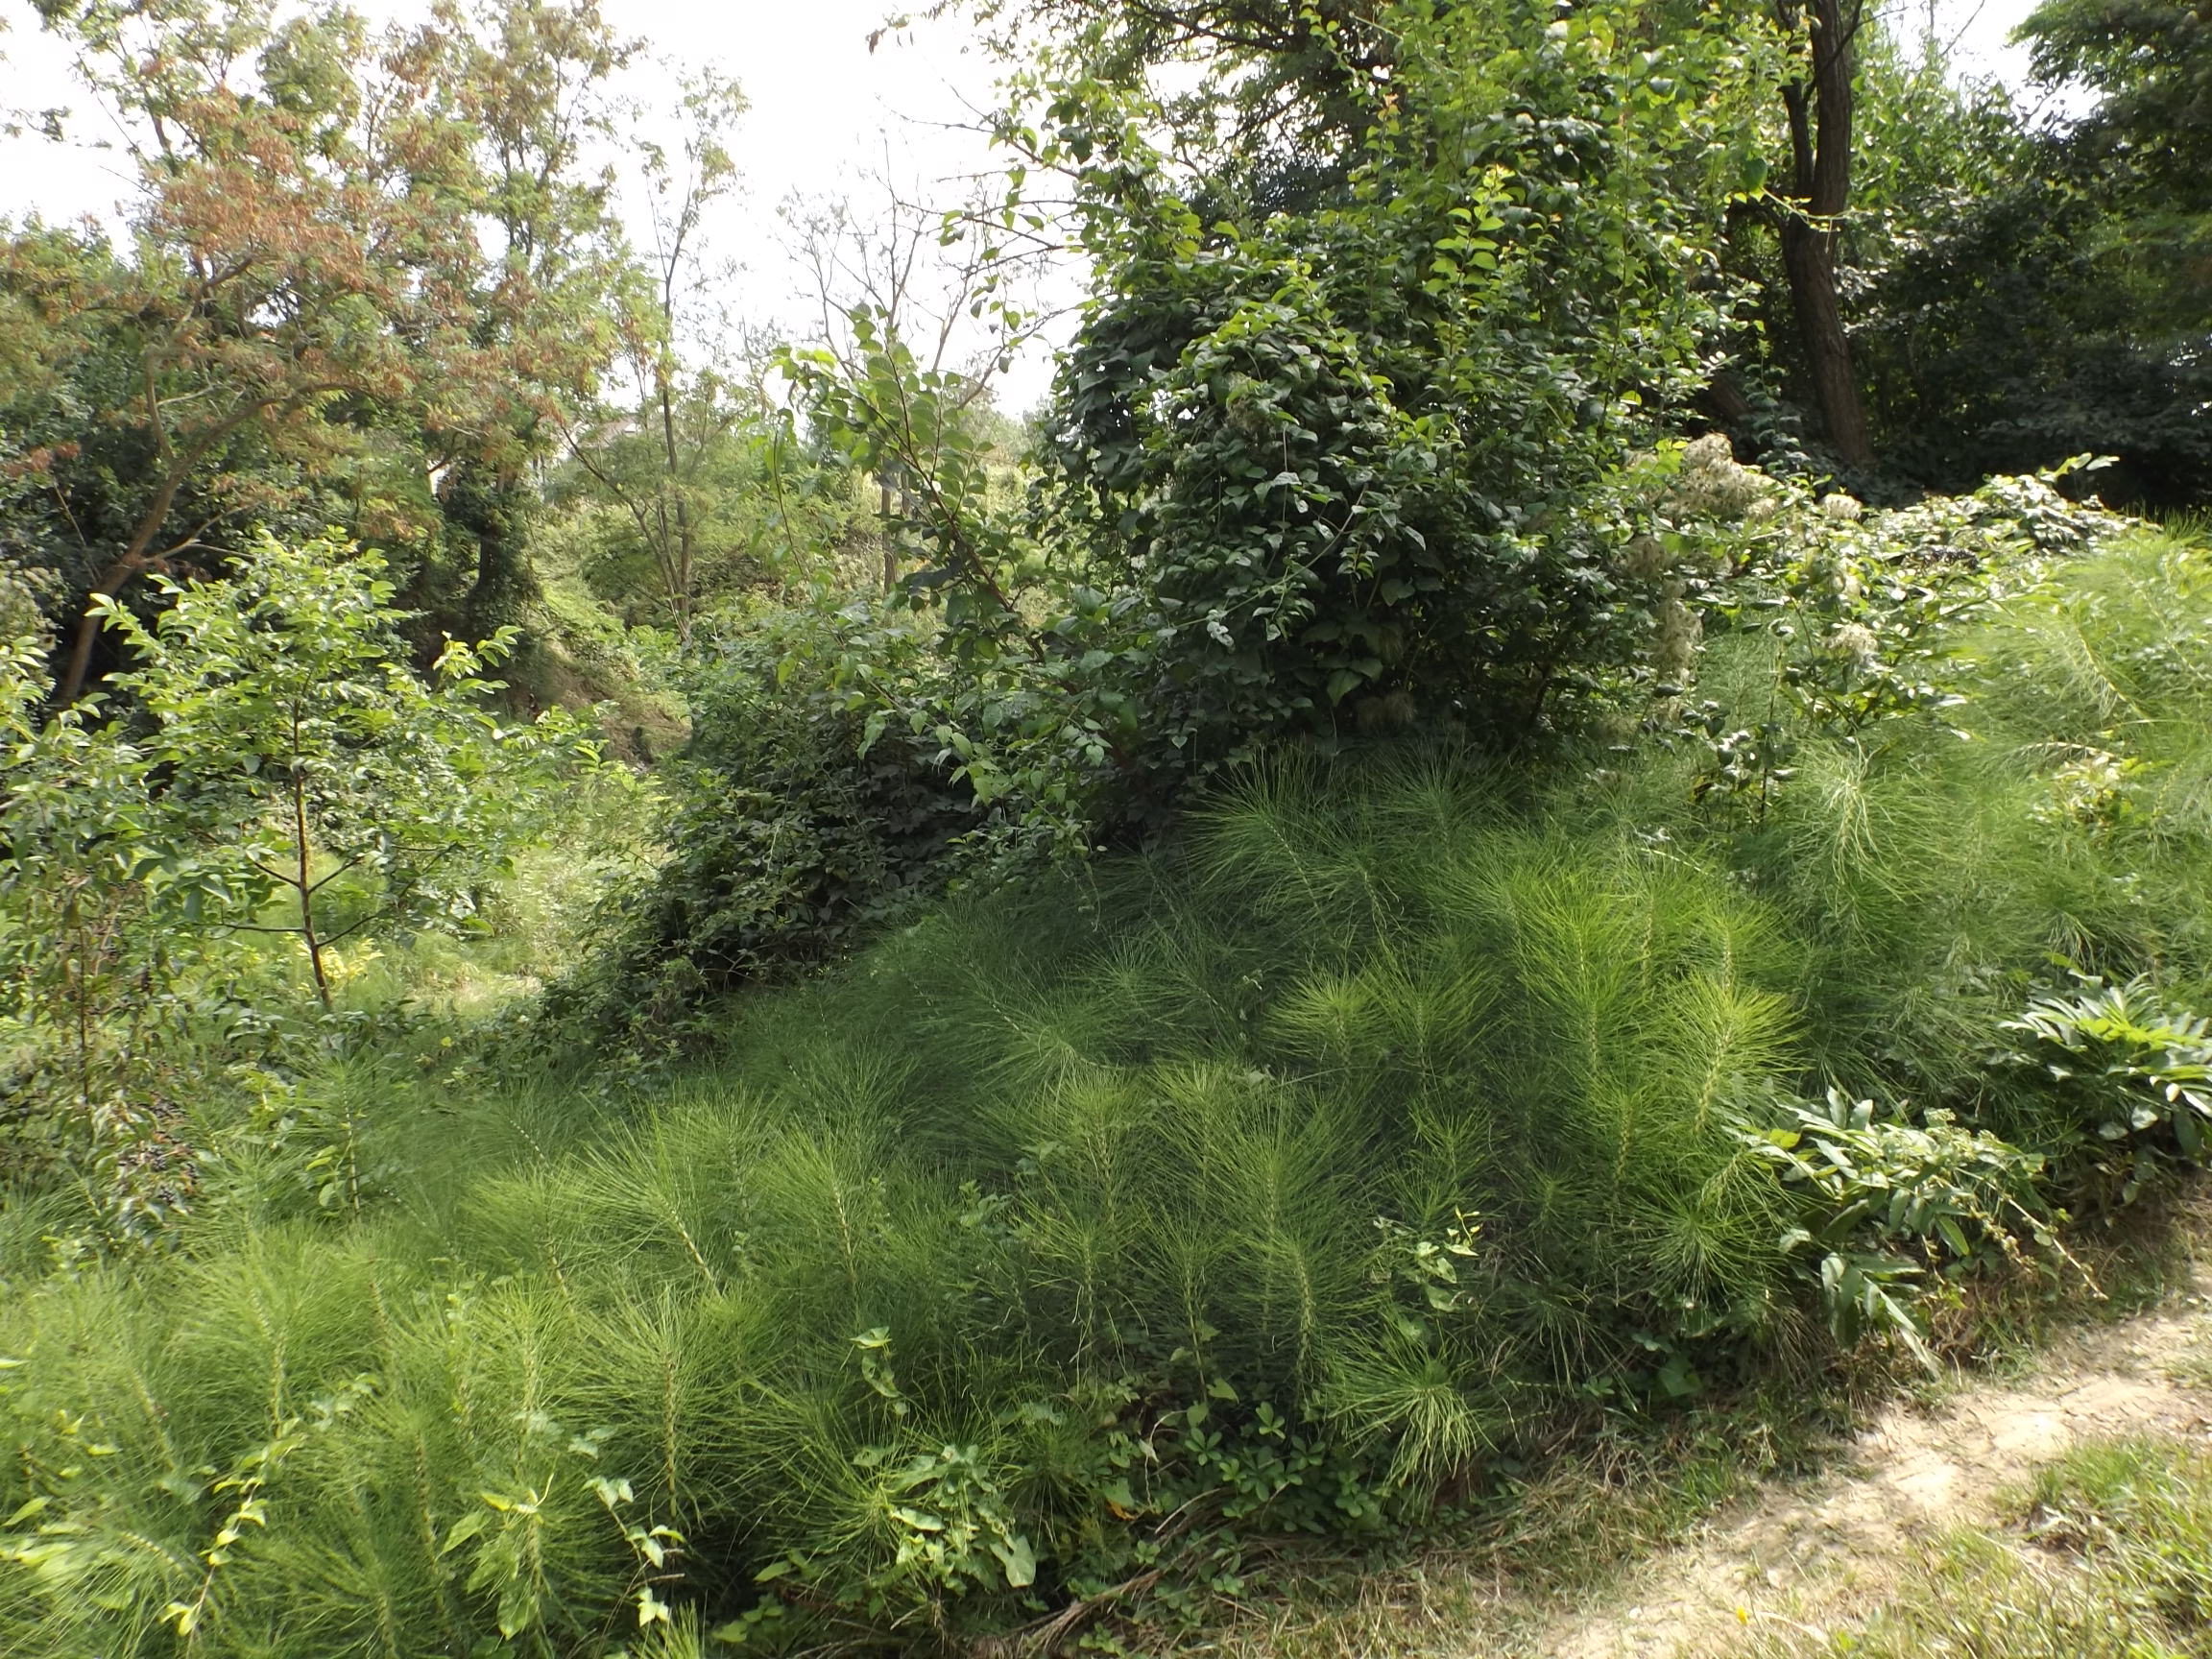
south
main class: Woodland
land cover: Broadleaved woodland
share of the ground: 50 - 75 %
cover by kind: broadleaved forest trees 65 %, herbaceous plants 25 %, shrubs 10 %
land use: Residential
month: August
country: BG
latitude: 43.2336
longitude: 27.9330
